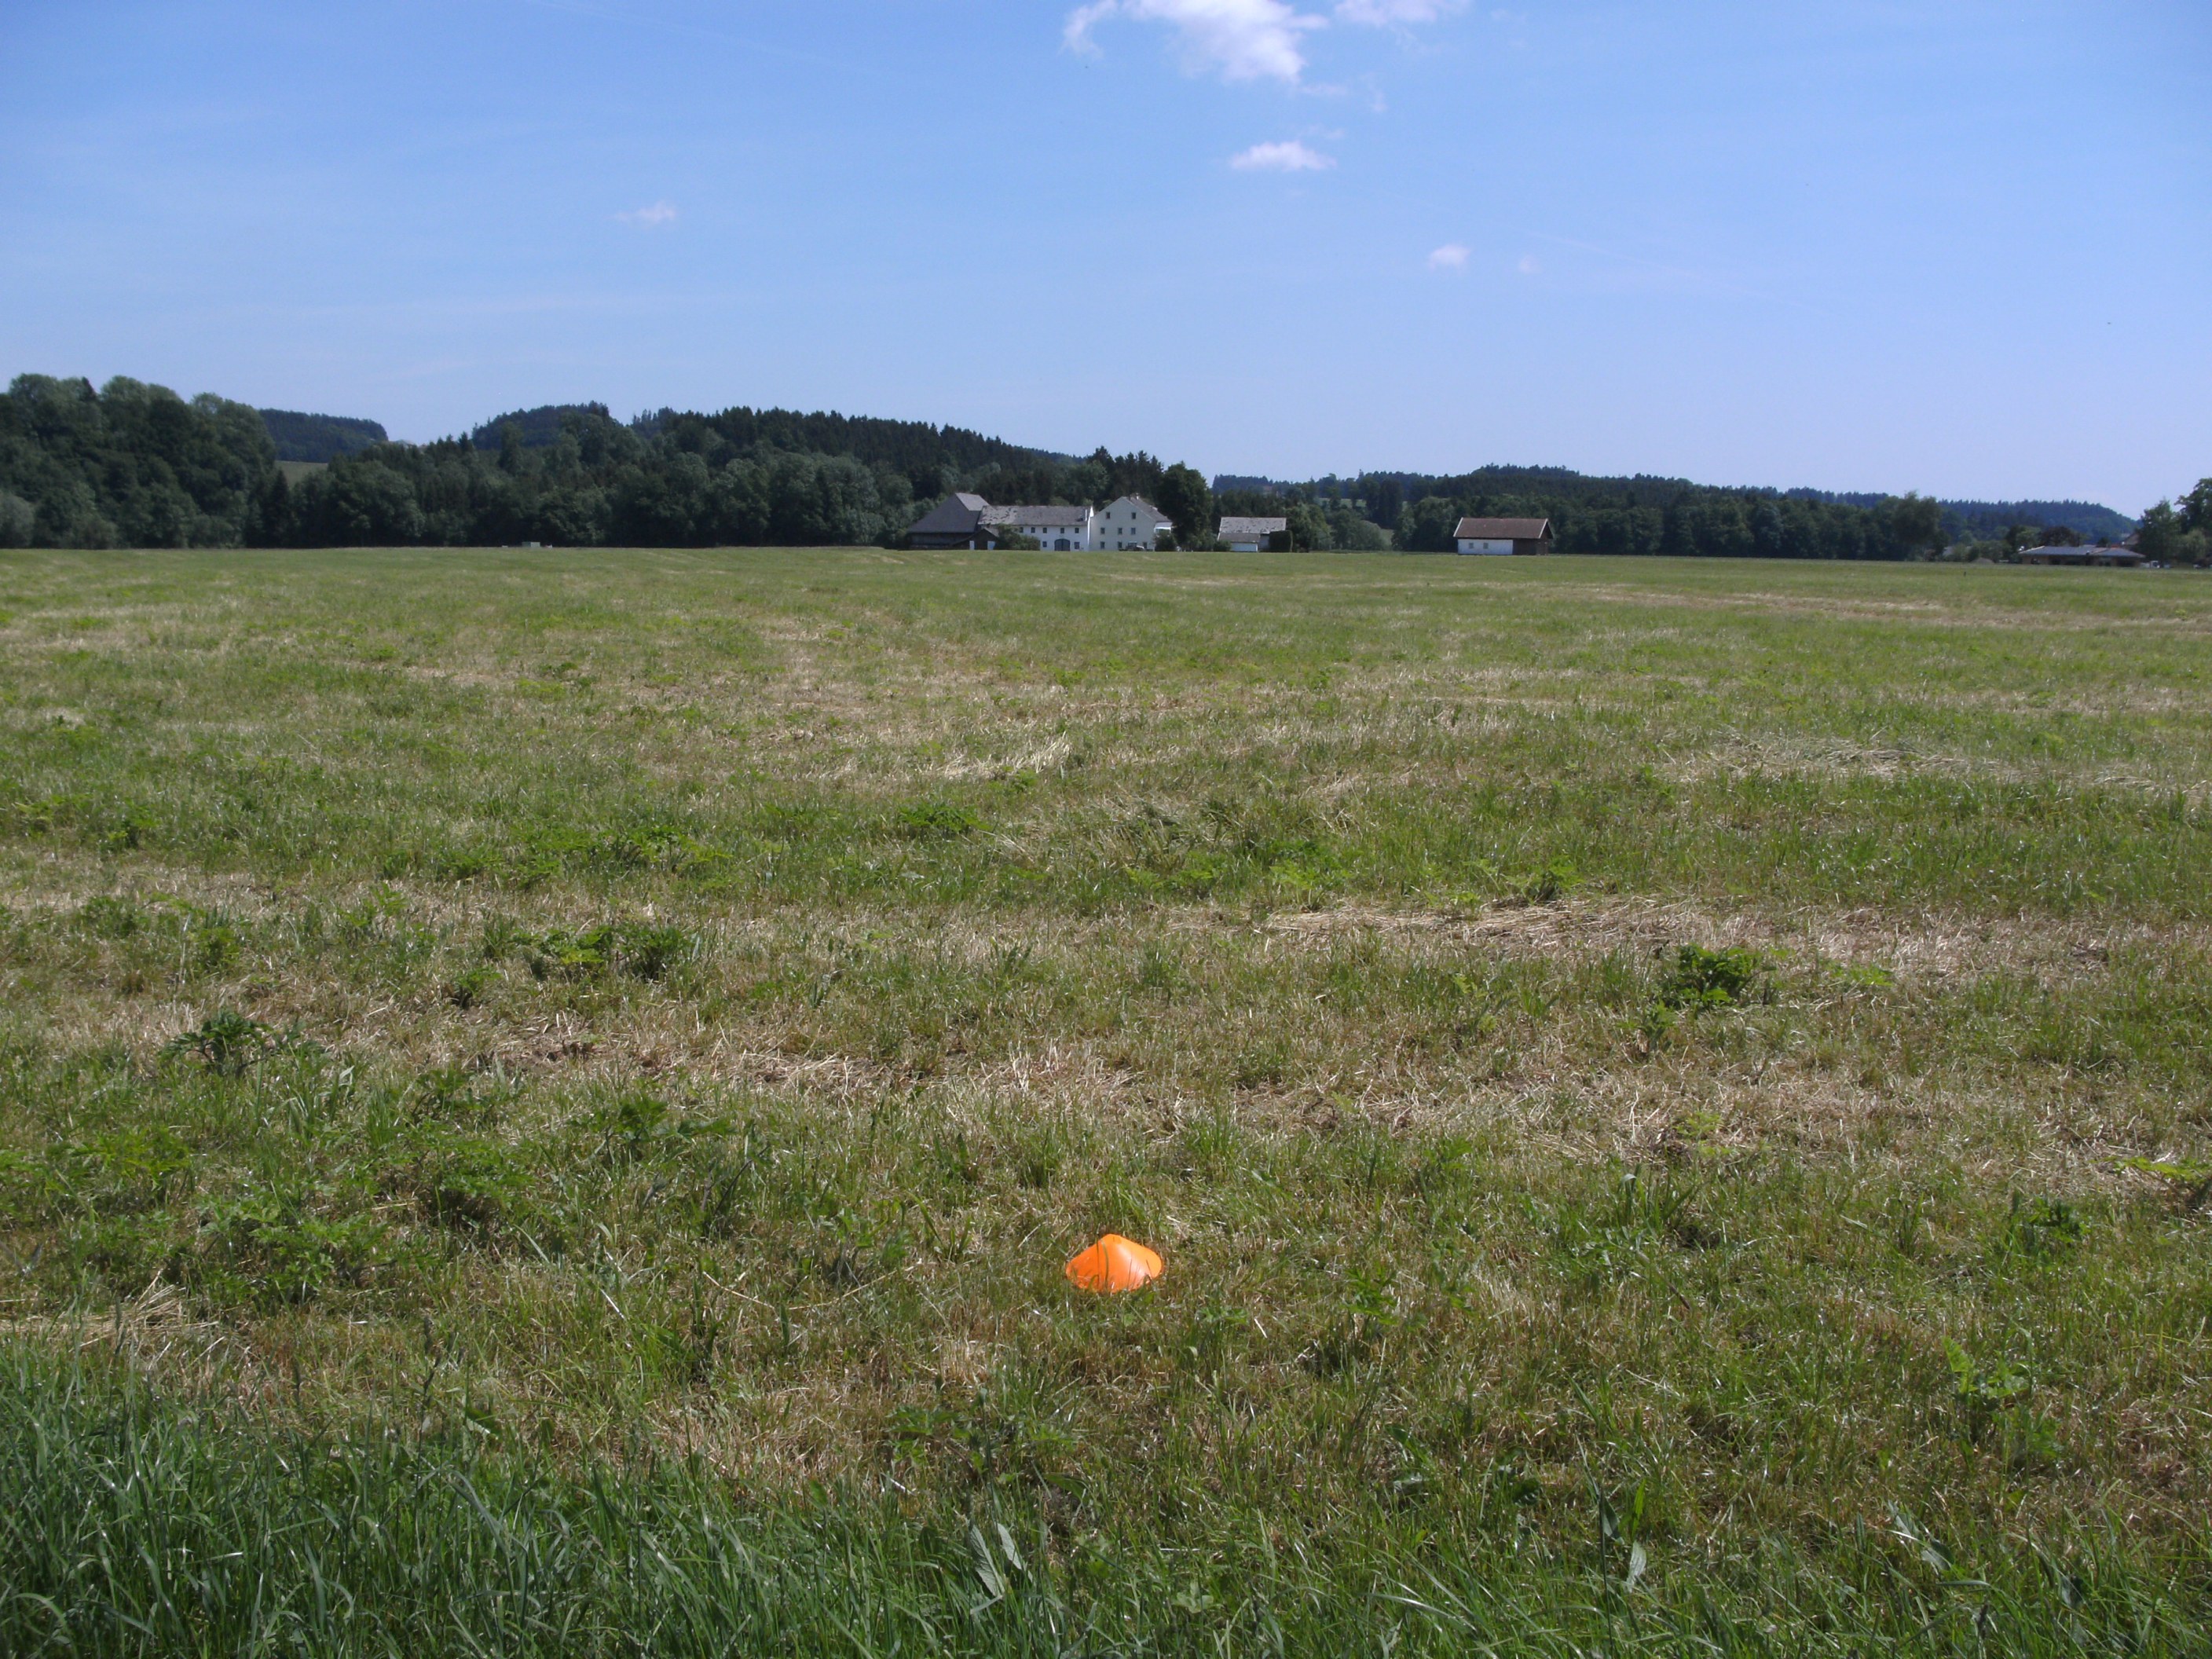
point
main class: Grassland
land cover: Grassland without tree/shrub cover
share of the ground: > 75 %
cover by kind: herbaceous plants 100 %
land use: Agriculture (excluding fallow land and kitchen gardens)
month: May
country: AT
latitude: 48.0222
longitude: 13.5523
